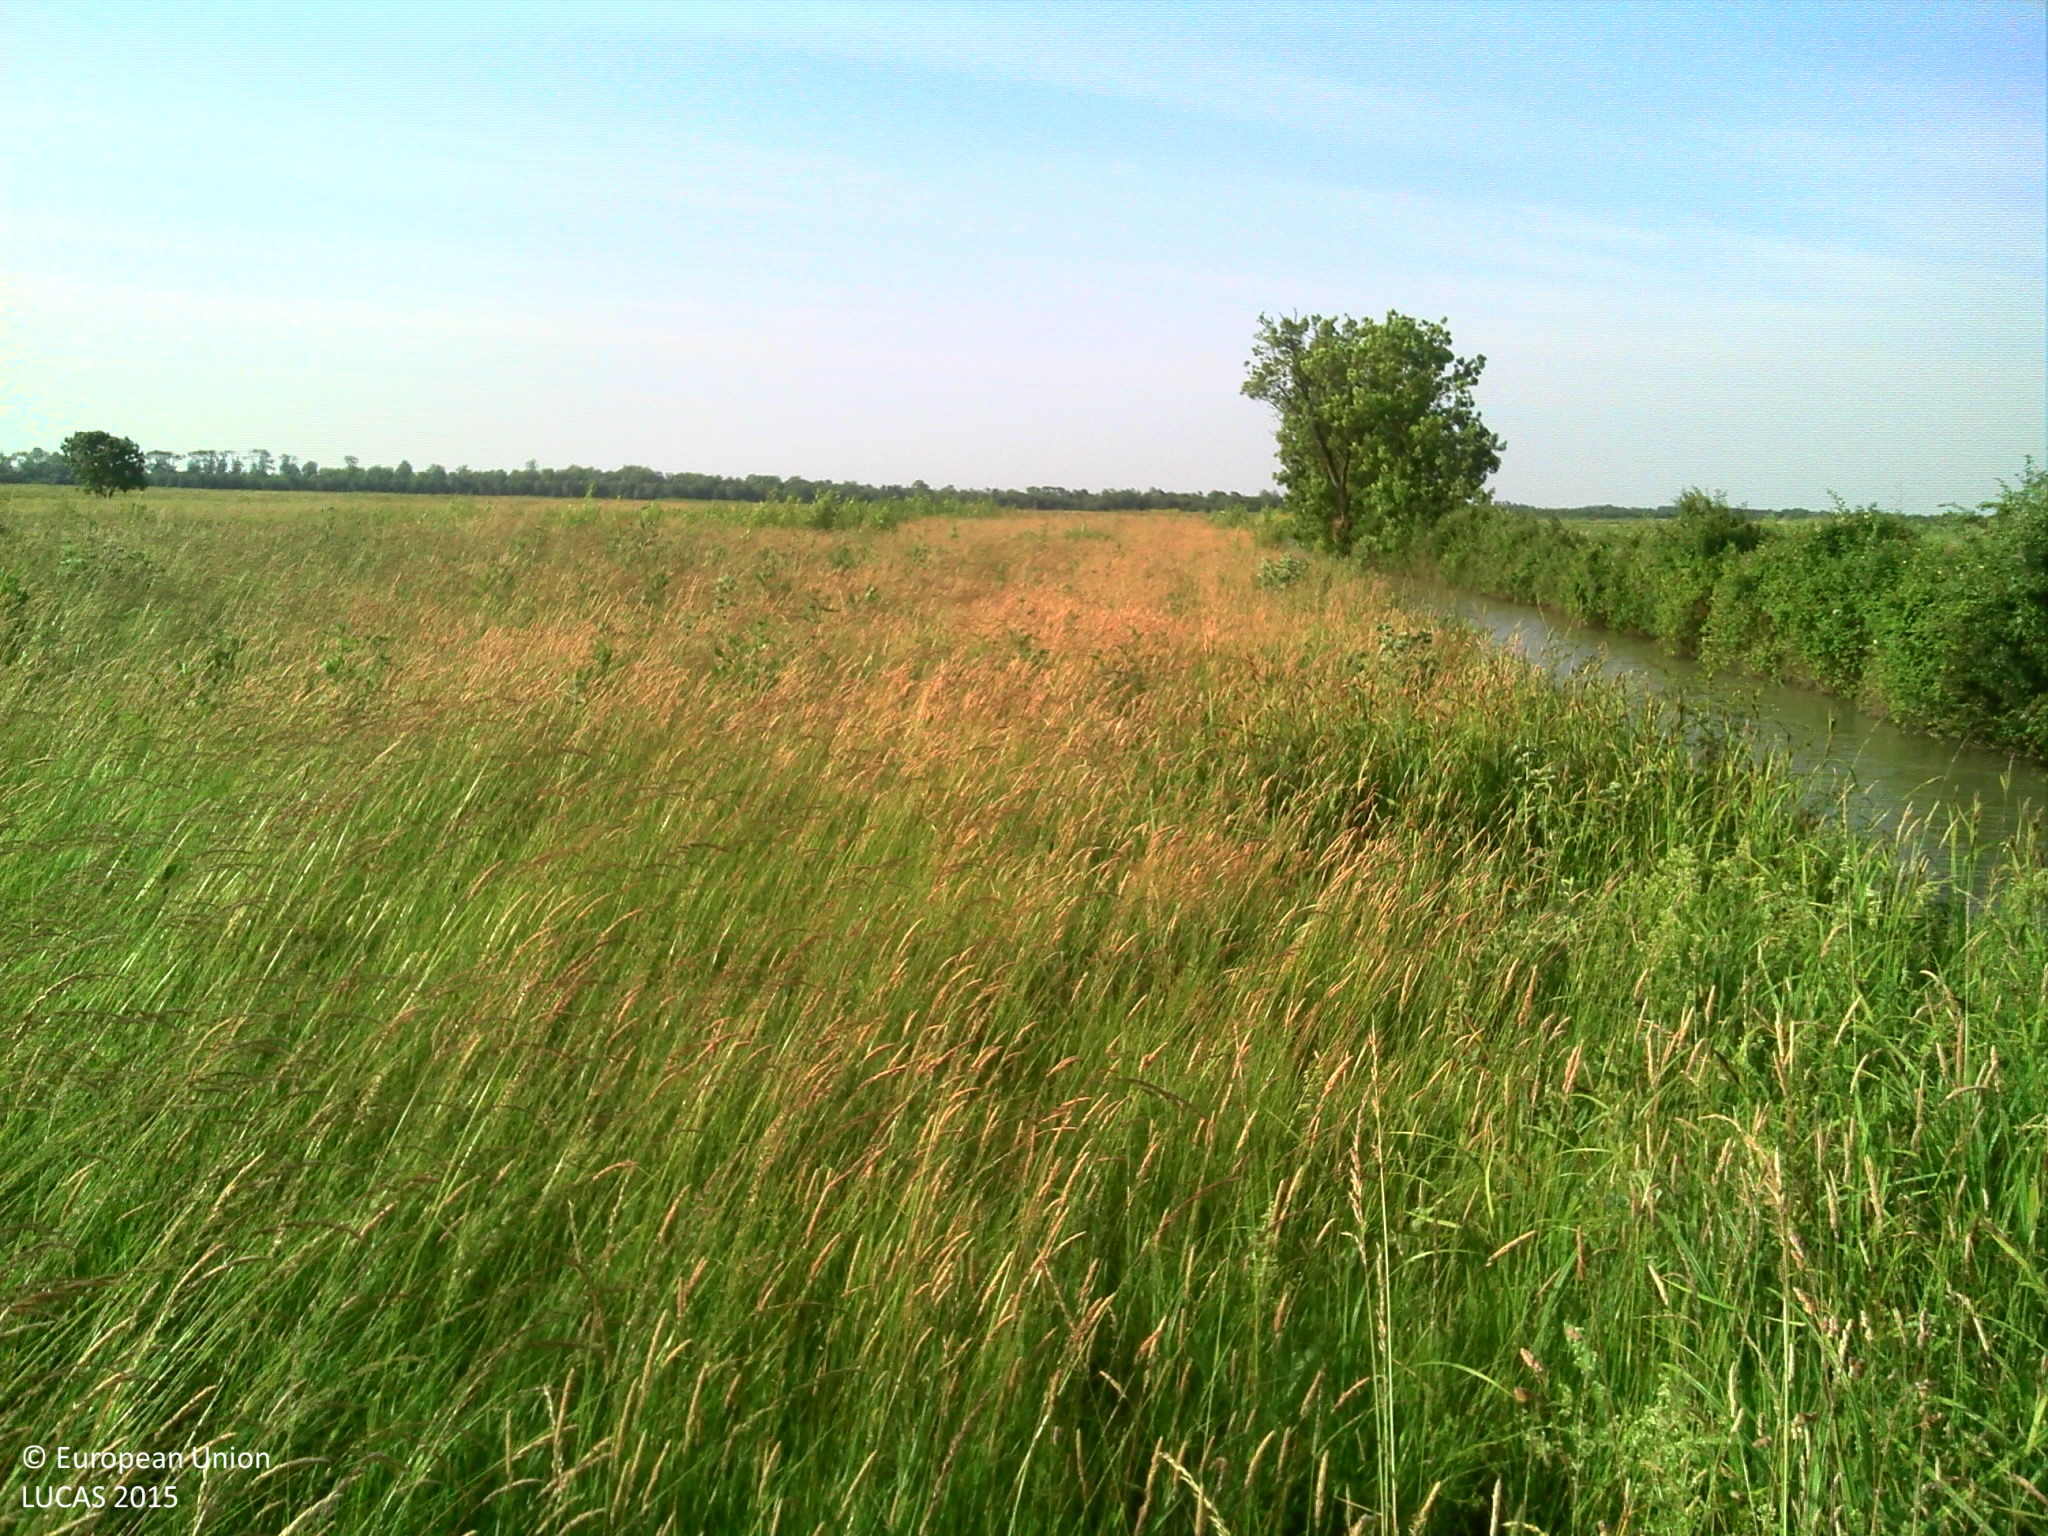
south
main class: Grassland
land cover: Grassland without tree/shrub cover
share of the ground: > 75 %
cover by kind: herbaceous plants 95 %, shrubs 5 %
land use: Agriculture (excluding fallow land and kitchen gardens)
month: June
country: FR
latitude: 46.0365
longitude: -0.9994
